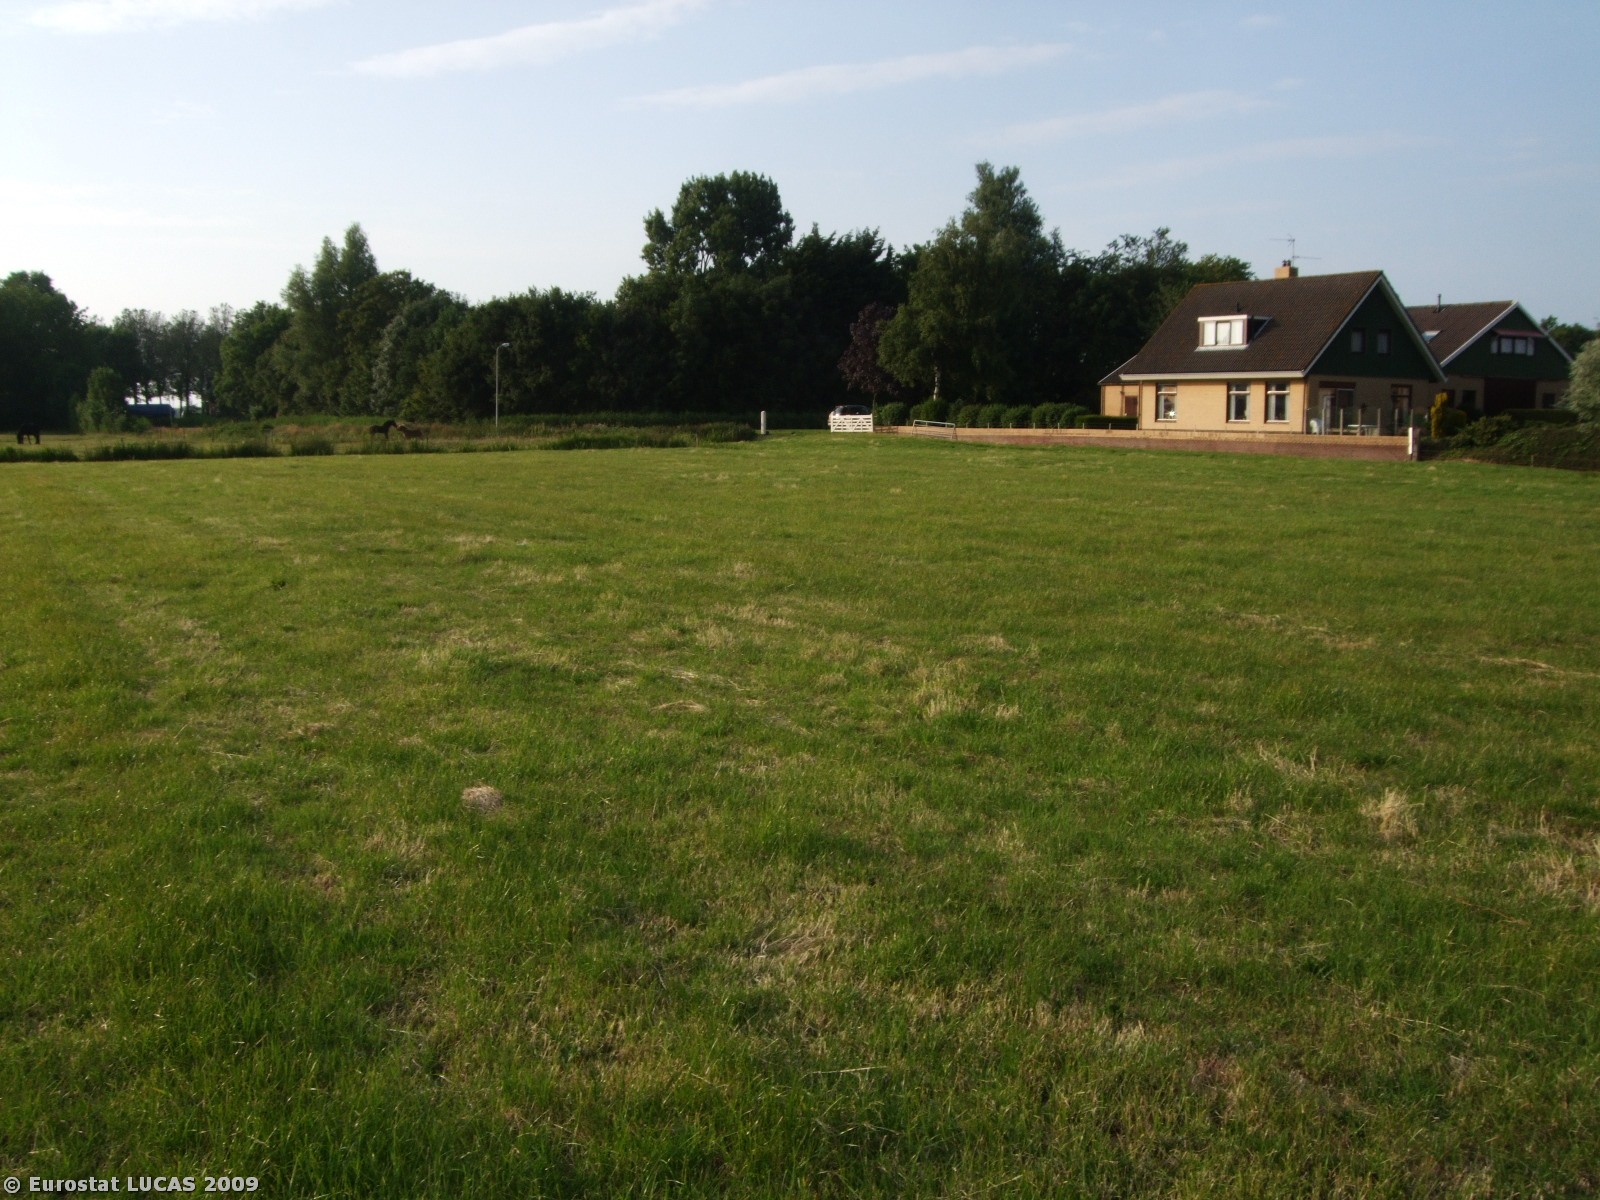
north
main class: Grassland
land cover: Grassland without tree/shrub cover
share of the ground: > 75 %
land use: Agriculture (excluding fallow land and kitchen gardens)
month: June
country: NL
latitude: 52.8916
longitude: 5.6439
